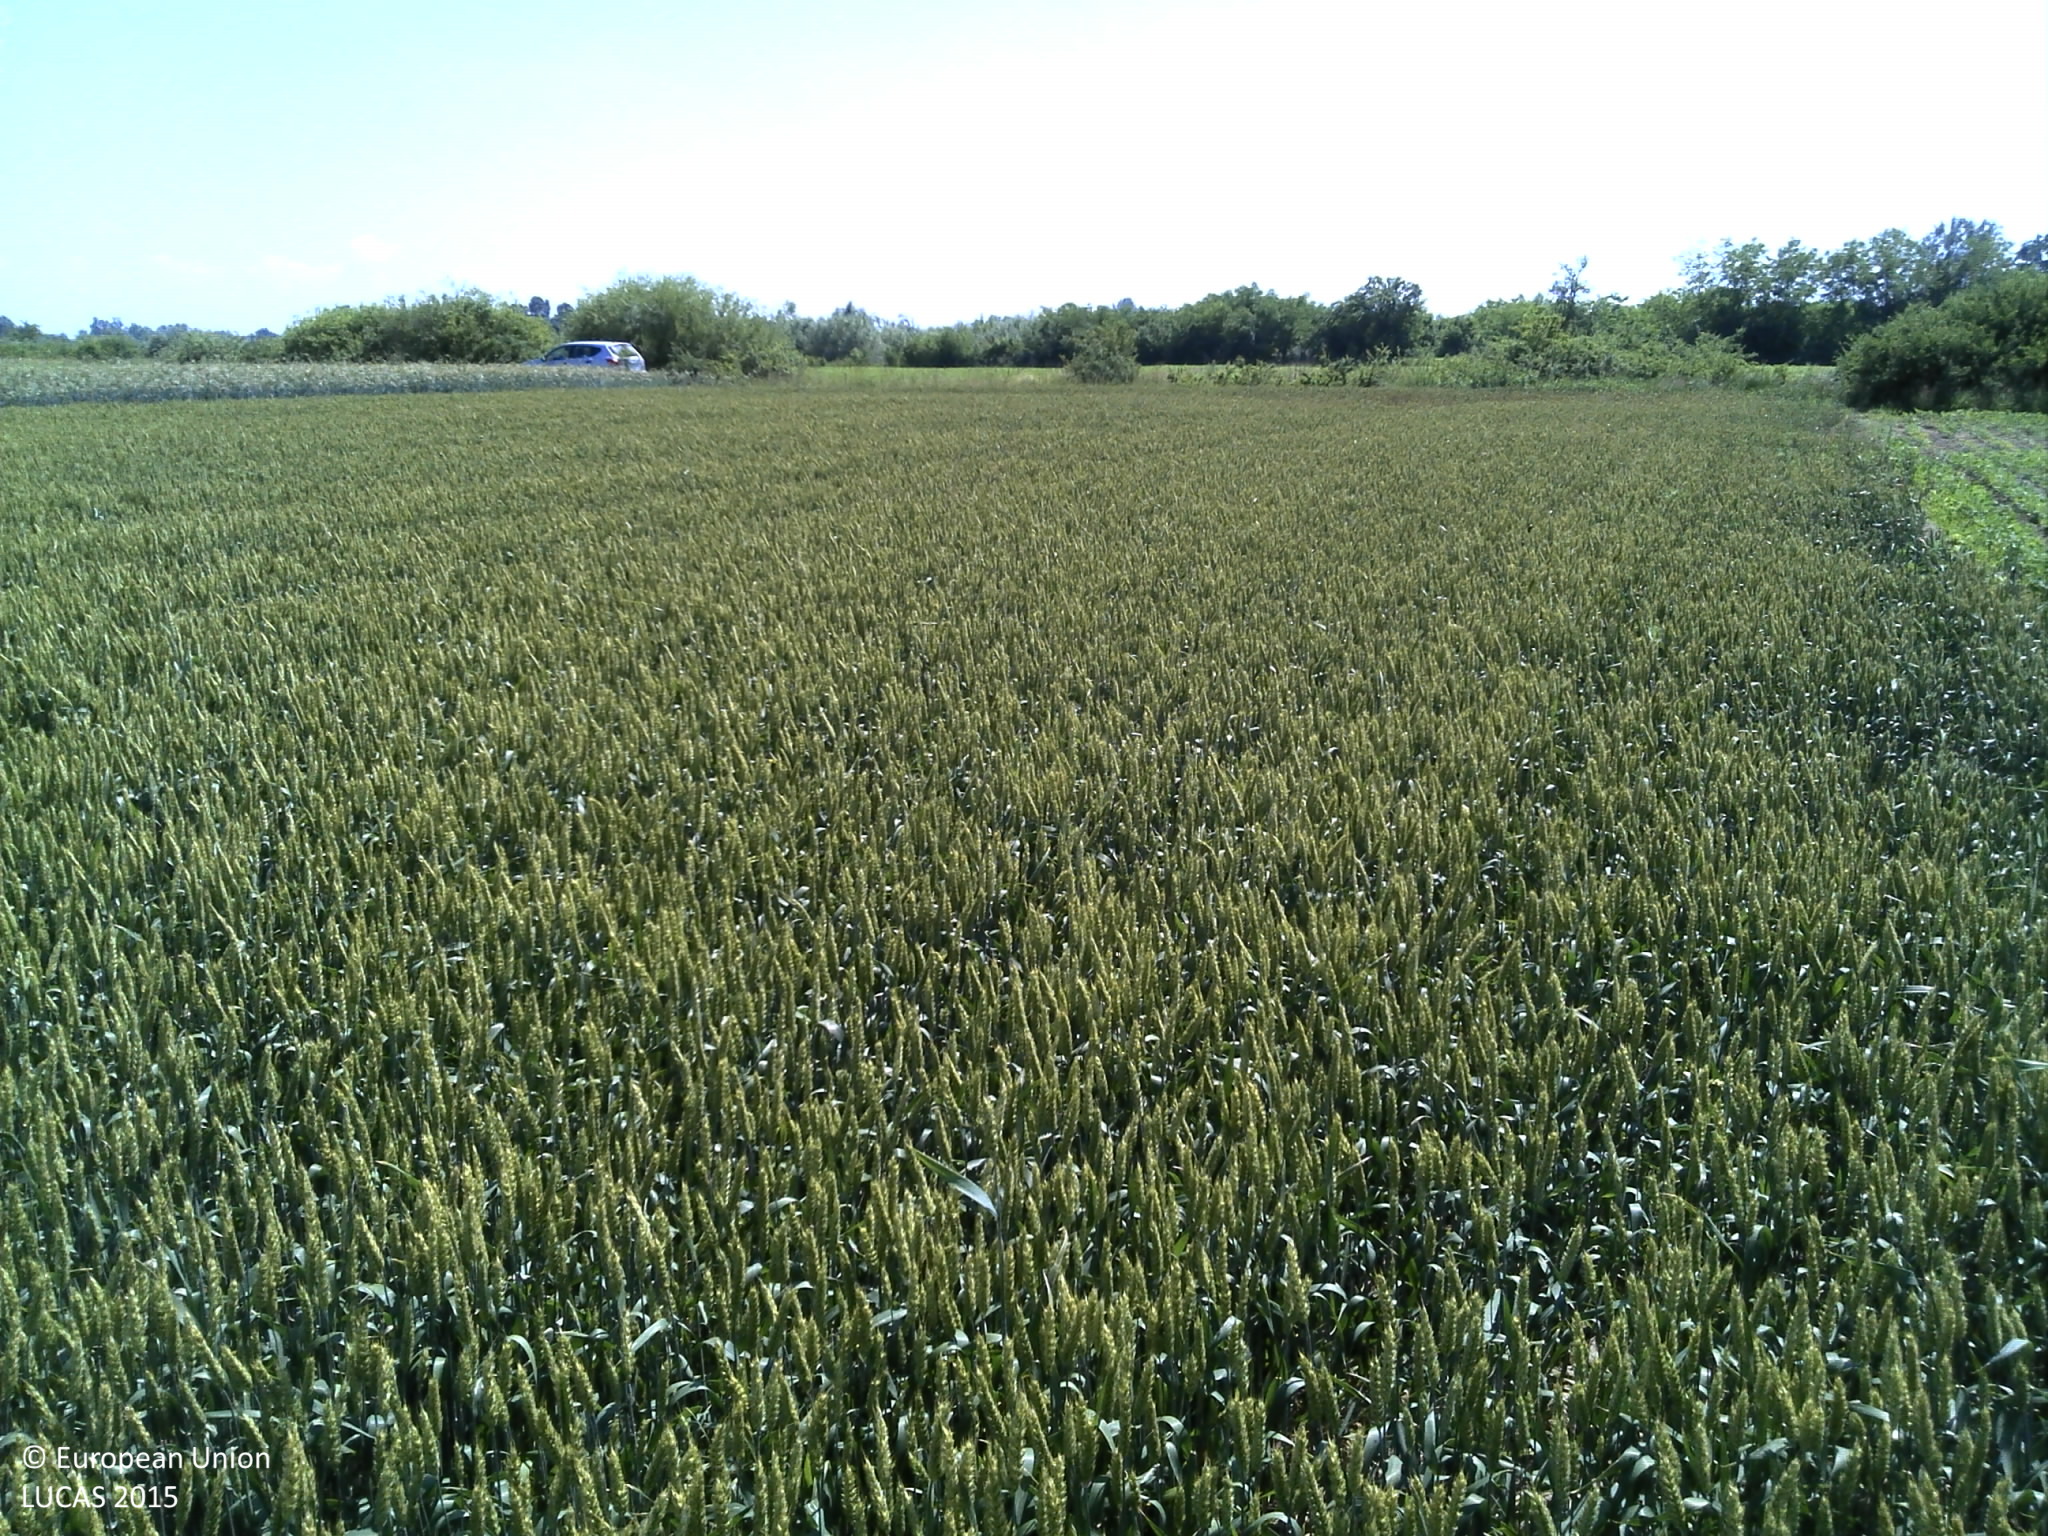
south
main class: Cropland
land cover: Common wheat
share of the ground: > 75 %
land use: Agriculture (excluding fallow land and kitchen gardens)
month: June
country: HR
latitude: 44.9567
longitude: 18.9944
